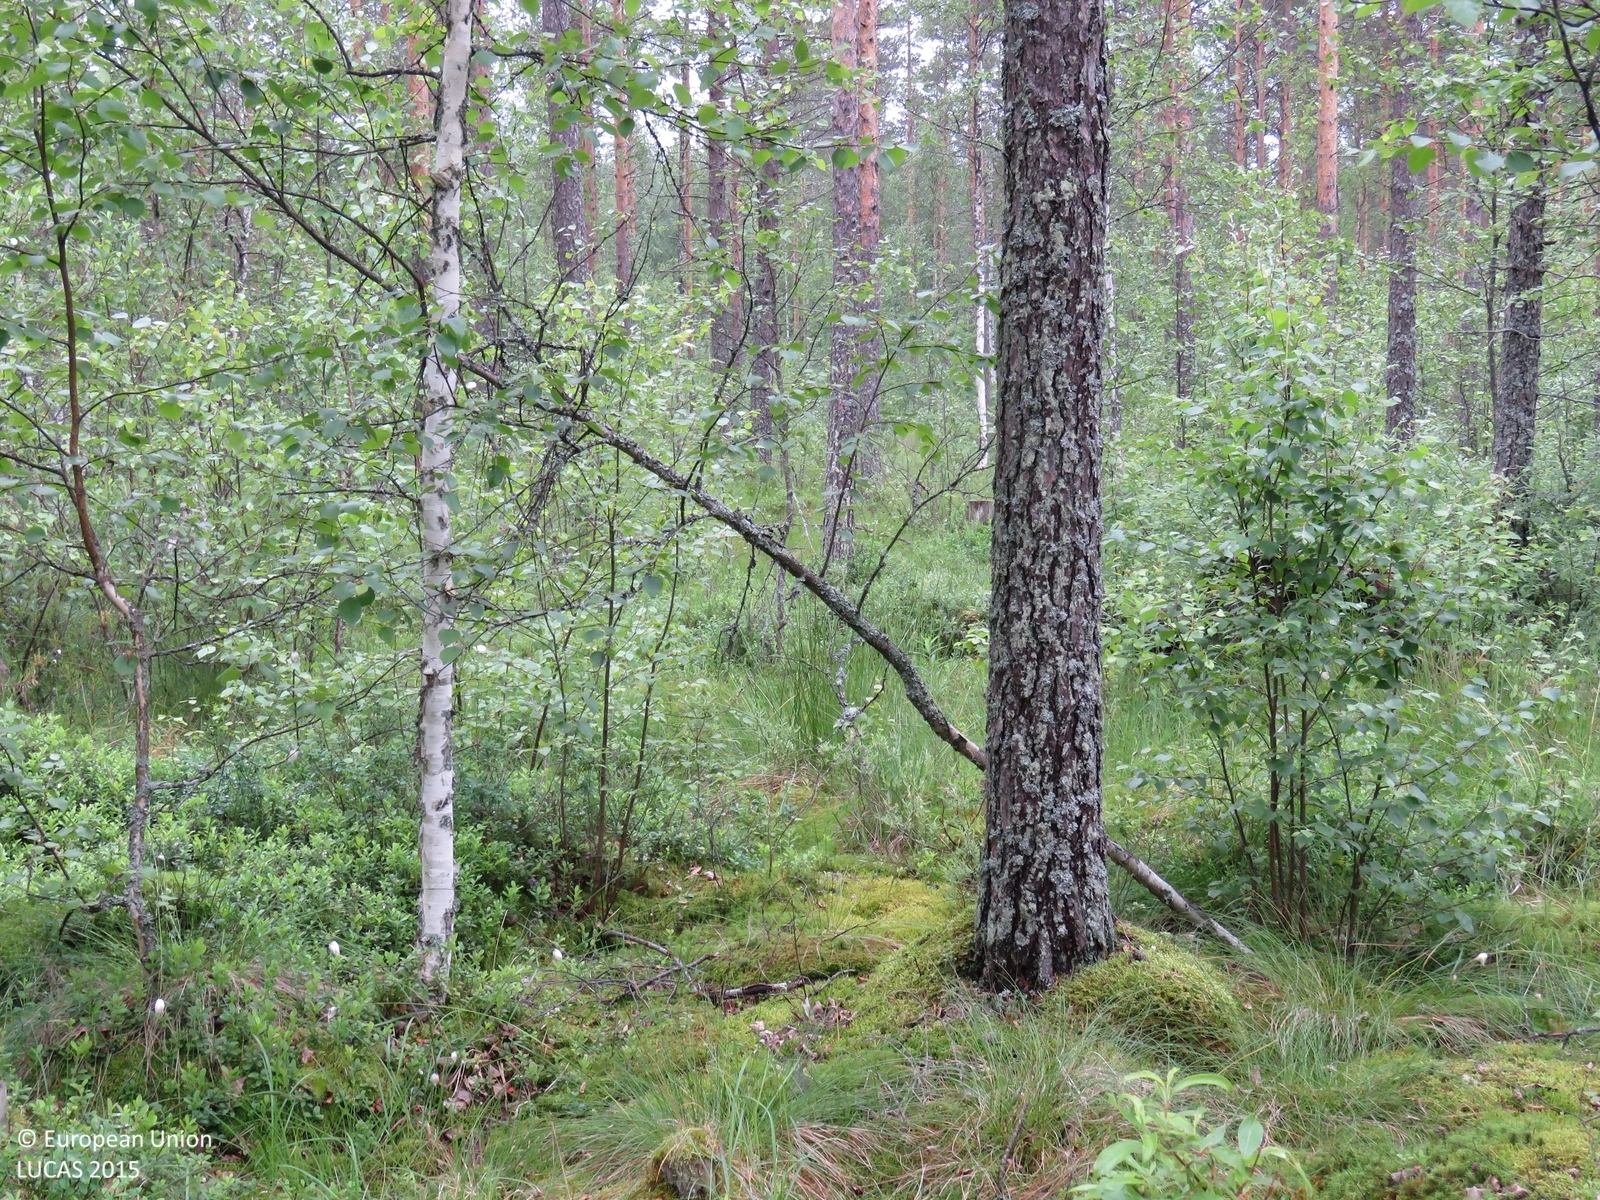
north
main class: Woodland
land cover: Pine dominated mixed woodland
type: boreal forest
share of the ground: > 75 %
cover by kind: broadleaved forest trees 50 %, coniferous forest trees 40 %, shrubs 5 %, herbaceous plants 5 %
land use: Forestry
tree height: > 5 m
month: July
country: FI
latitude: 64.3939
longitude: 26.3499
